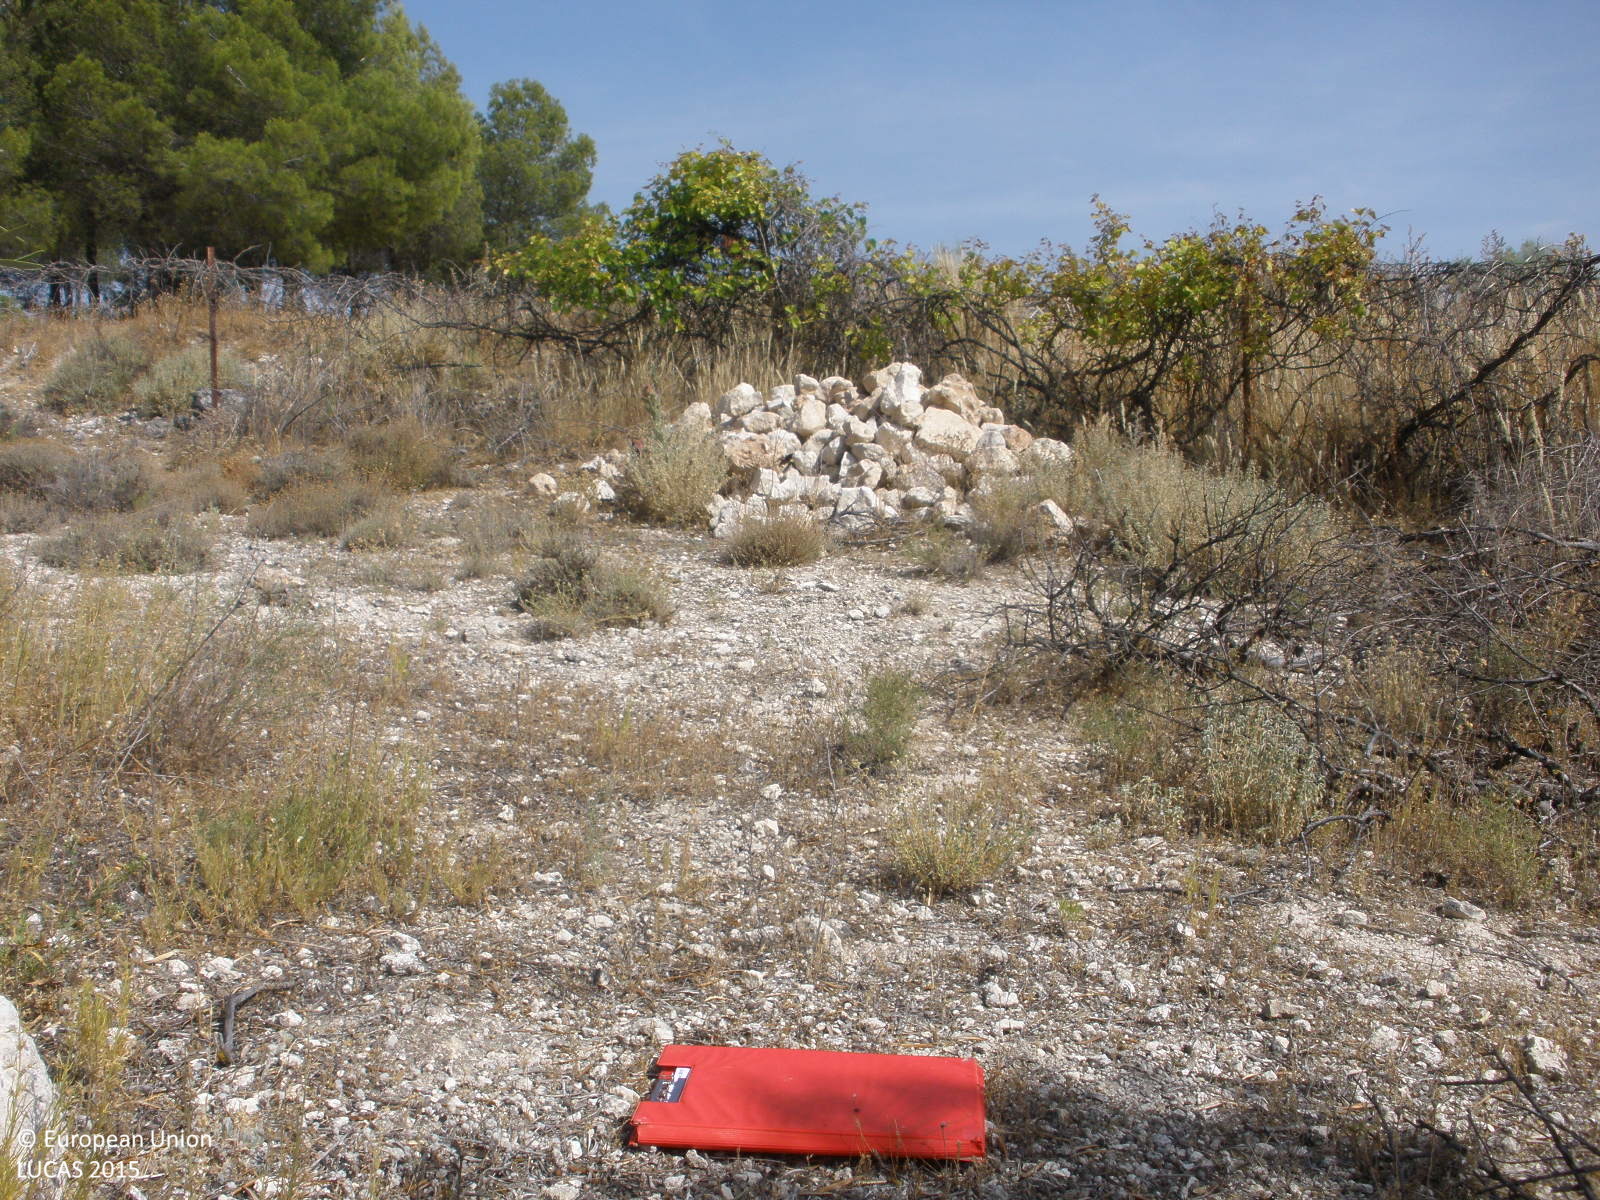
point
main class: Cropland
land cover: Olive groves
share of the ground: 25 - 50 %
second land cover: Grassland without tree/shrub cover
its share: 10 - 25 %
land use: Agriculture (excluding fallow land and kitchen gardens)
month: July
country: ES
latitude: 40.3479
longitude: -3.4191
